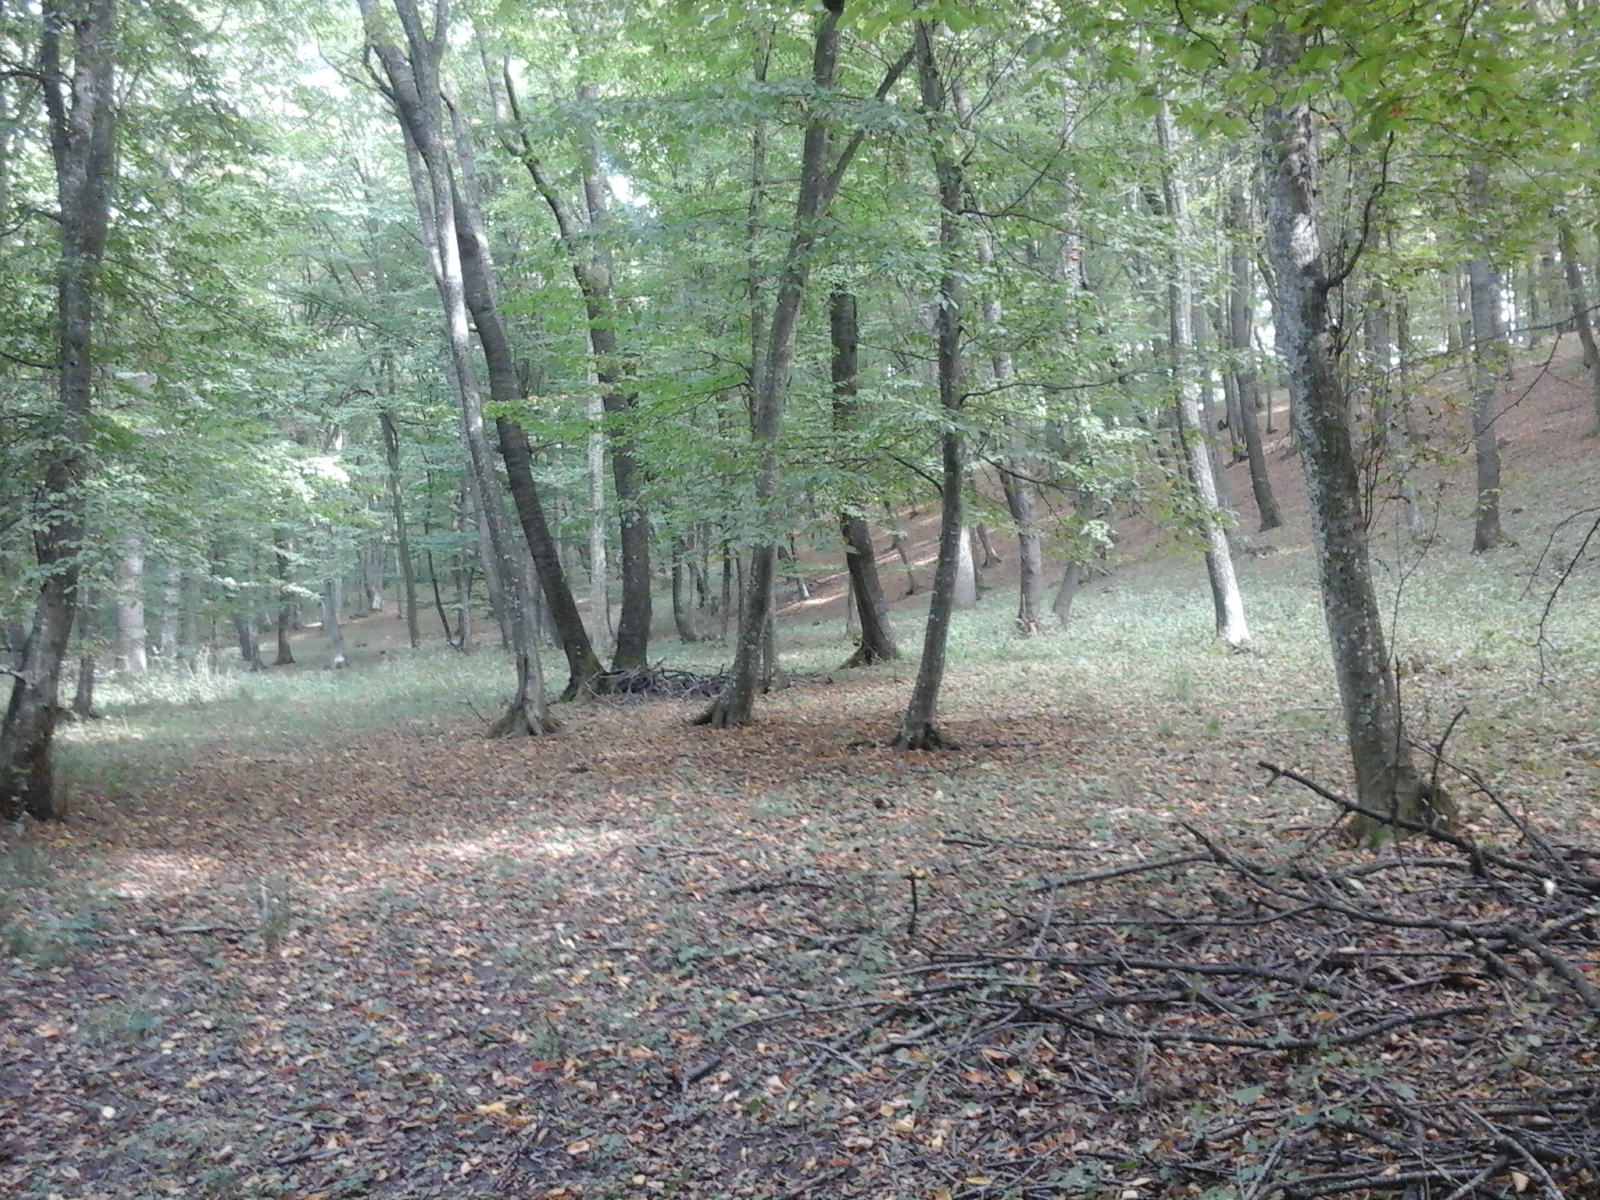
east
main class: Woodland
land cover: Broadleaved woodland
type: mesophytic deciduous forest
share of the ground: > 75 %
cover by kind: broadleaved forest trees 100 %
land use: Forestry
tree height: > 5 m
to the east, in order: Broadleaved woodland
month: September
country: RO
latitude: 46.9286
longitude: 24.0952
